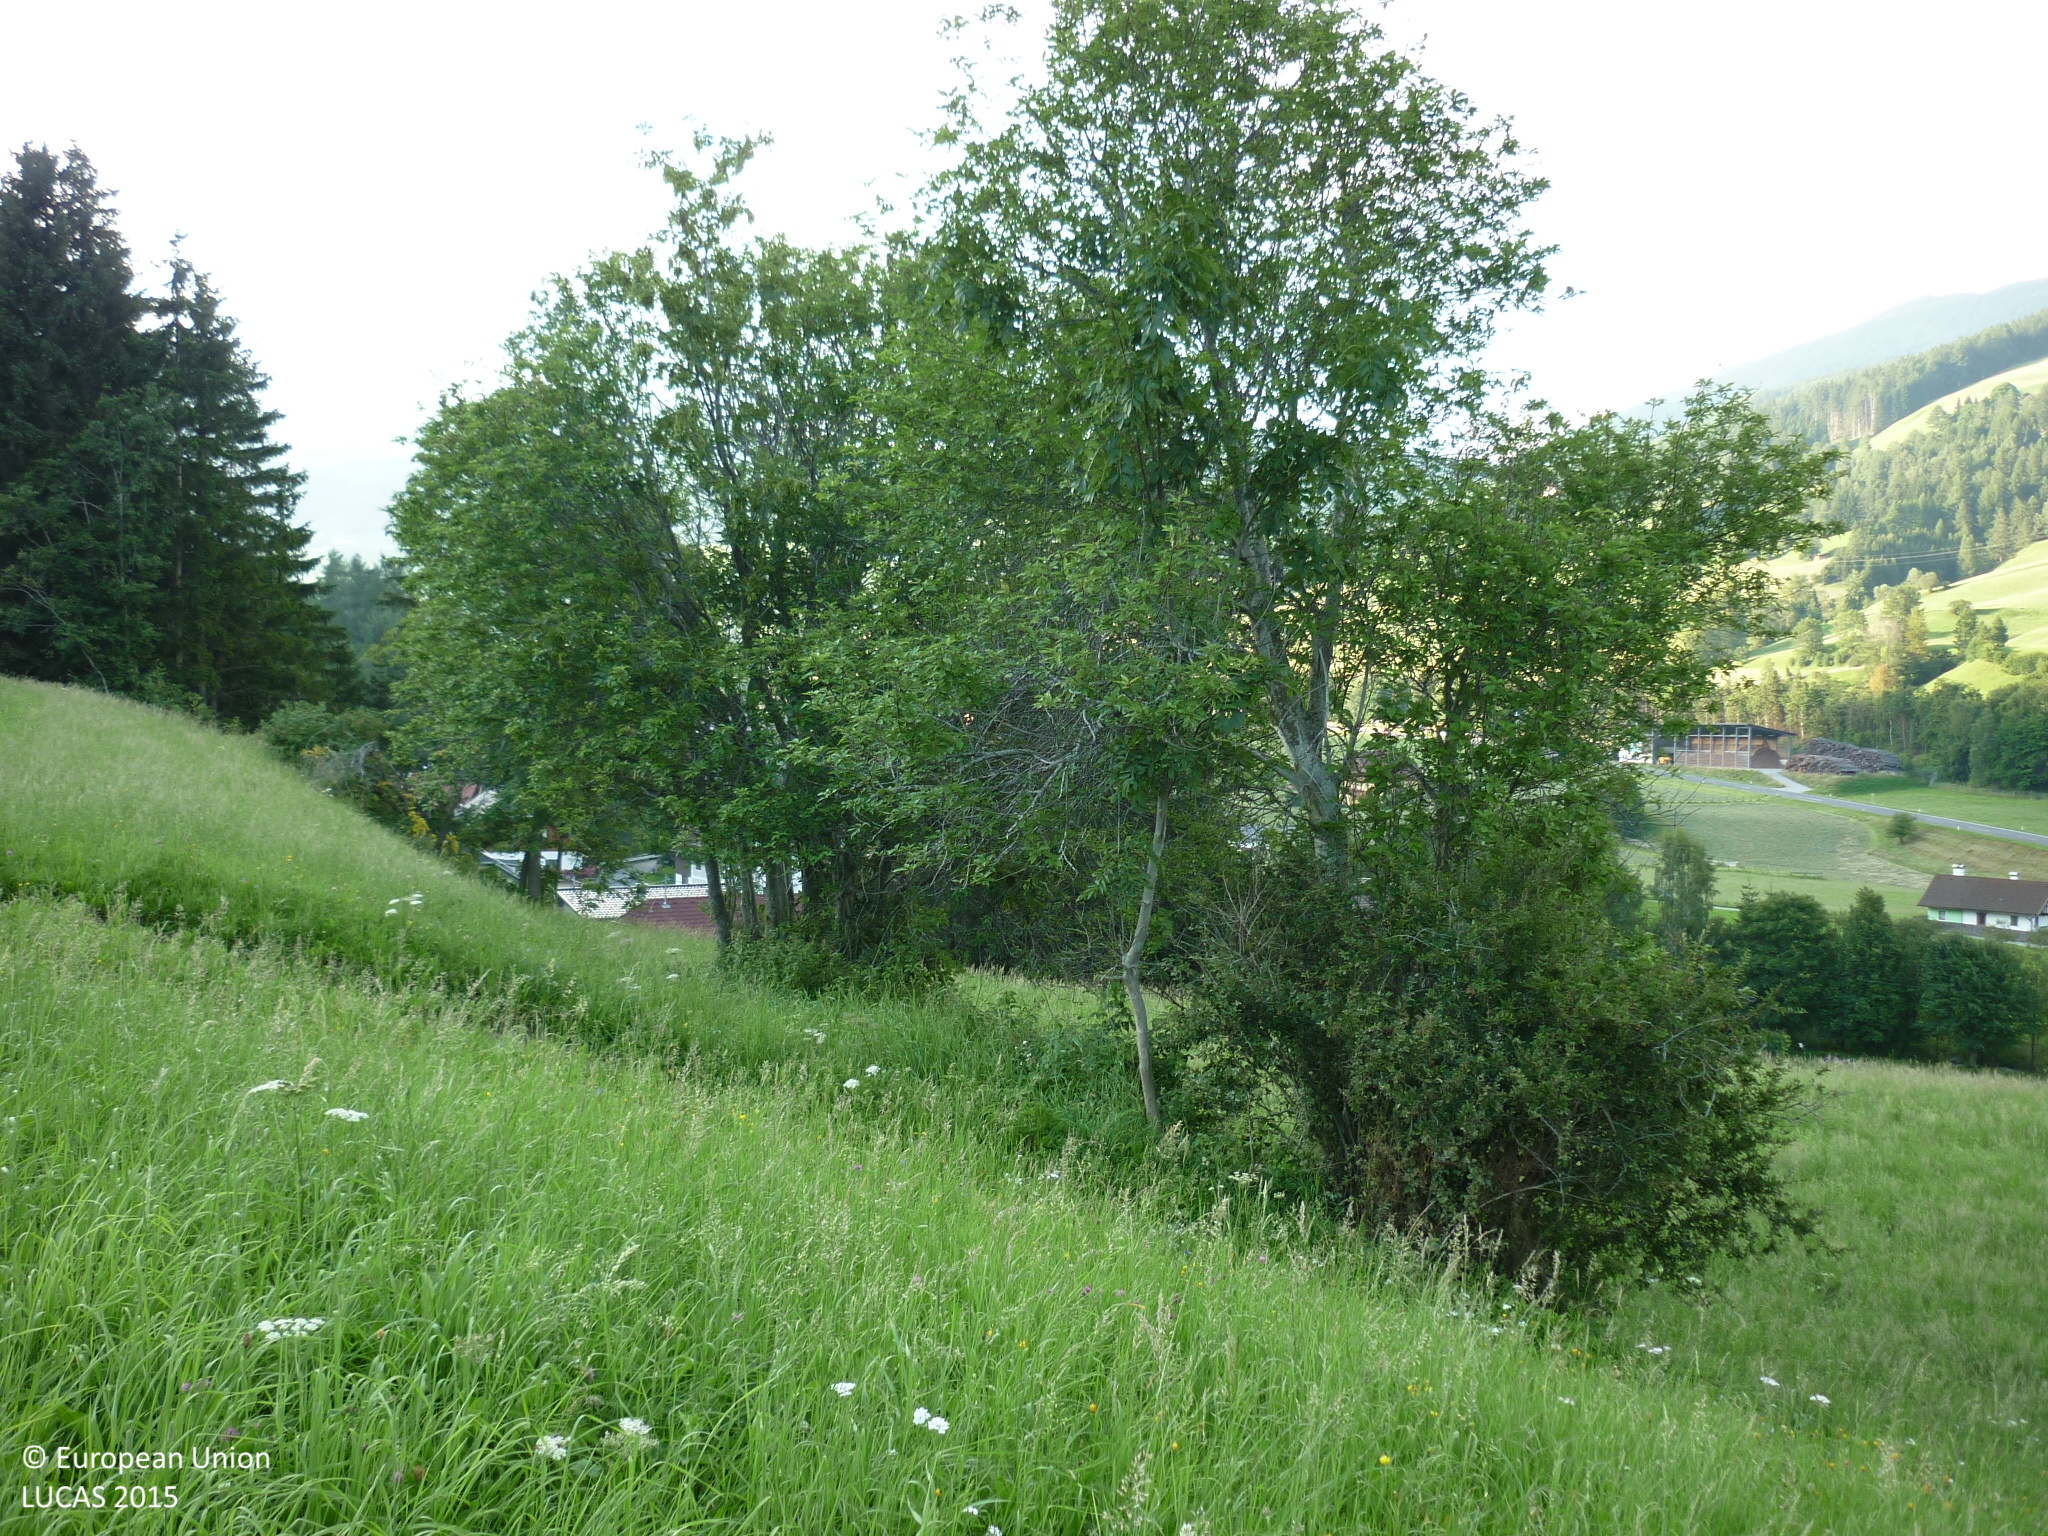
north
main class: Grassland
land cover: Grassland without tree/shrub cover
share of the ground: > 75 %
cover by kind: herbaceous plants 100 %
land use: Agriculture (excluding fallow land and kitchen gardens)
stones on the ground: < 10 %
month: August
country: AT
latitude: 47.0112
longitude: 13.6151
